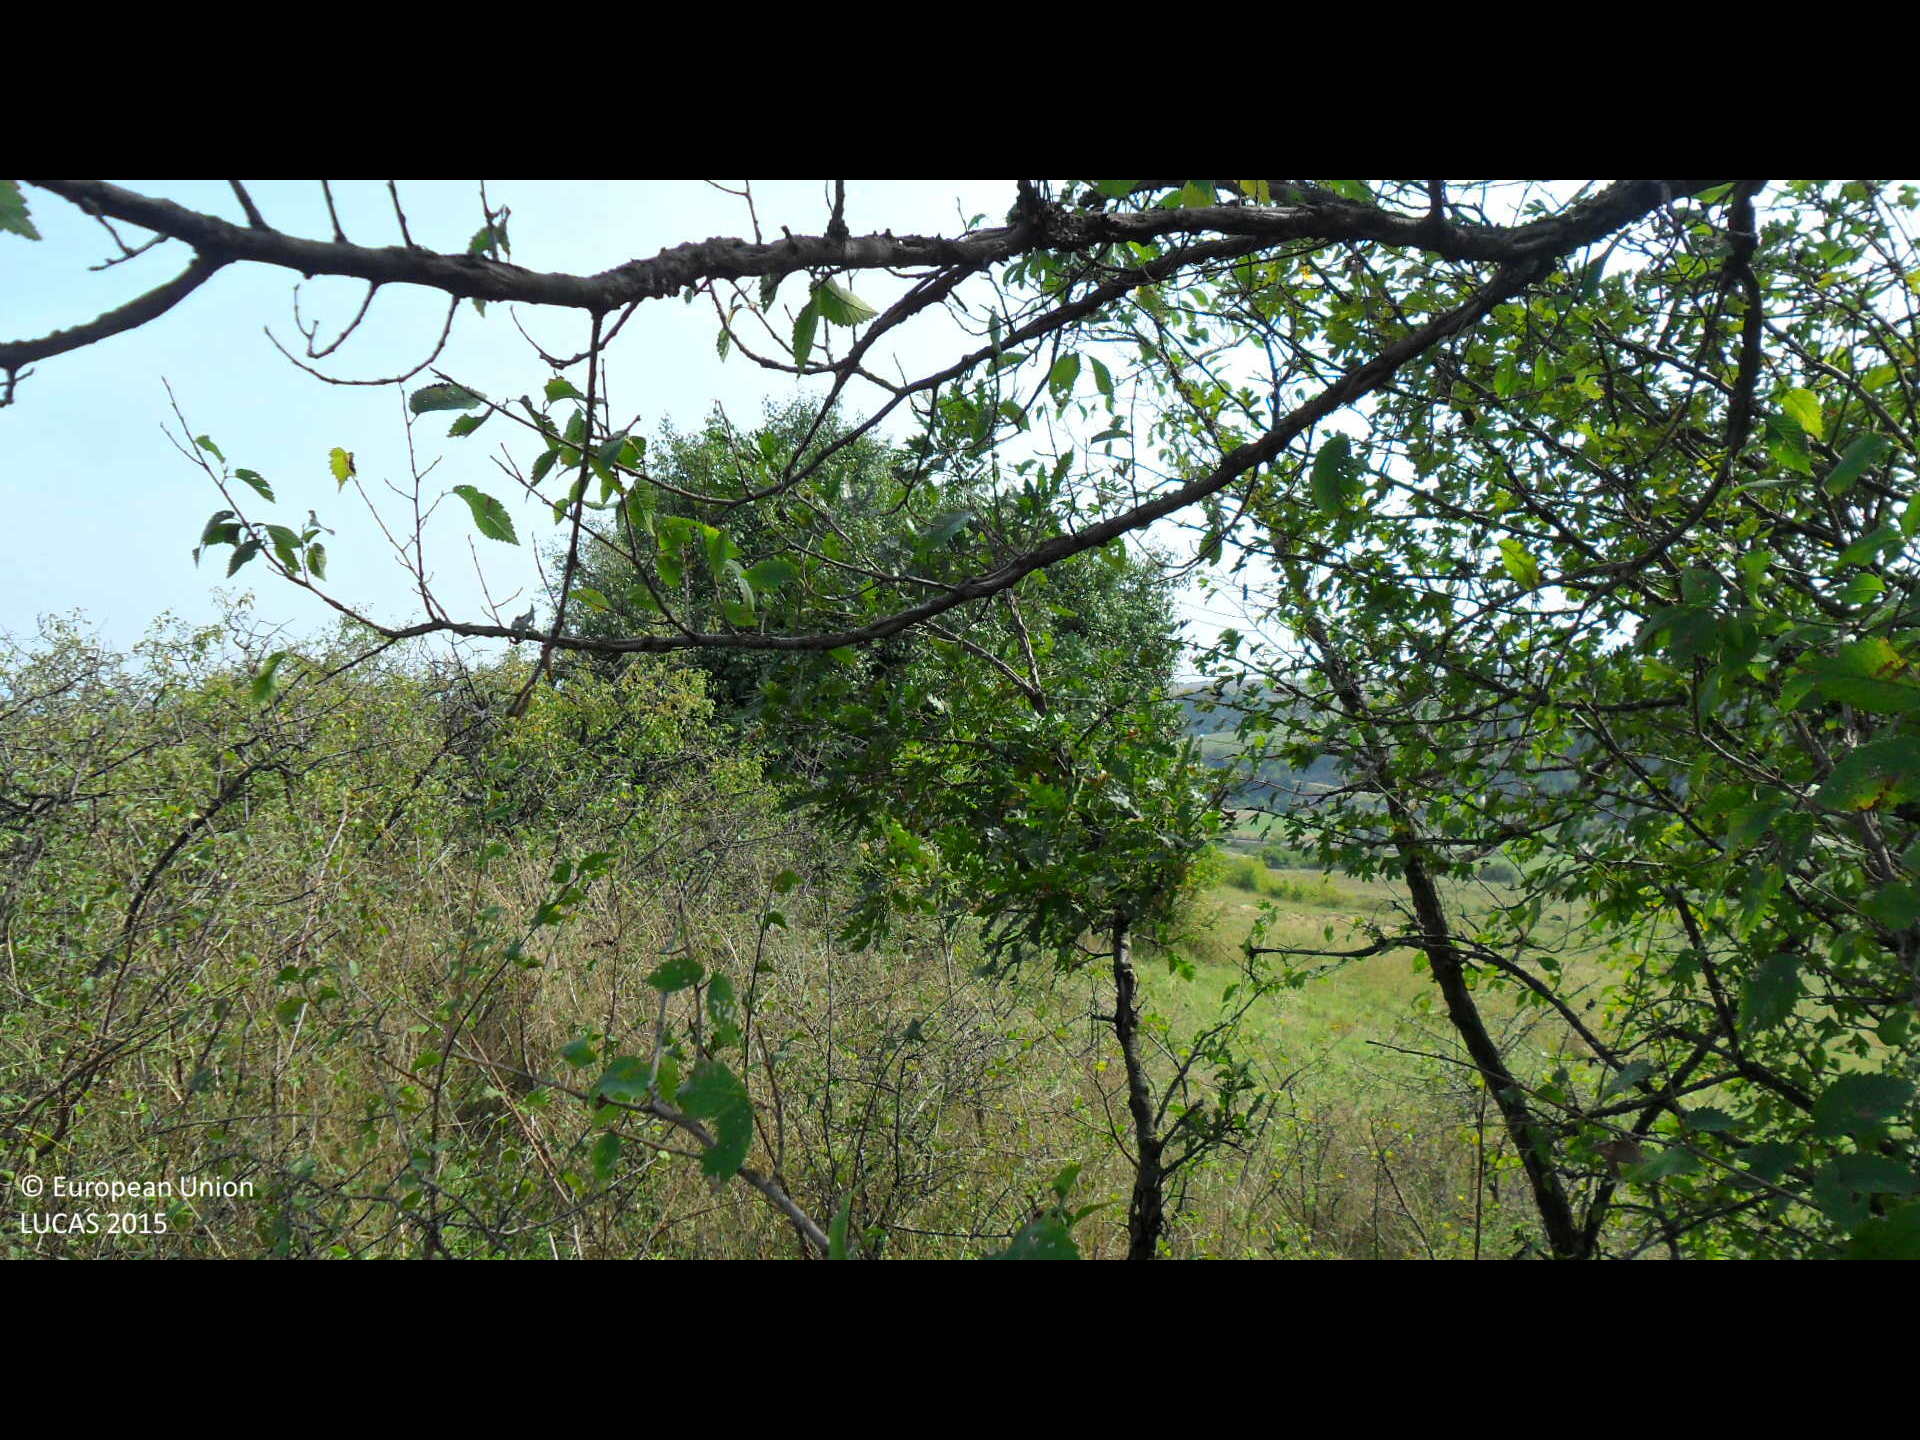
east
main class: Shrubland
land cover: Shrubland with sparse tree cover
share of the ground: > 75 %
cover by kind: shrubs 95 %, broadleaved forest trees 5 %
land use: Semi-natural and natural areas not in use
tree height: < 5 m
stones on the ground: < 10 %
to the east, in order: Shrubland with sparse tree cover; Grassland with sparse tree/shrub cover; Rocks and stones; Grassland with sparse tree/shrub cover
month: September
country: BG
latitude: 43.0315
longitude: 26.5334
